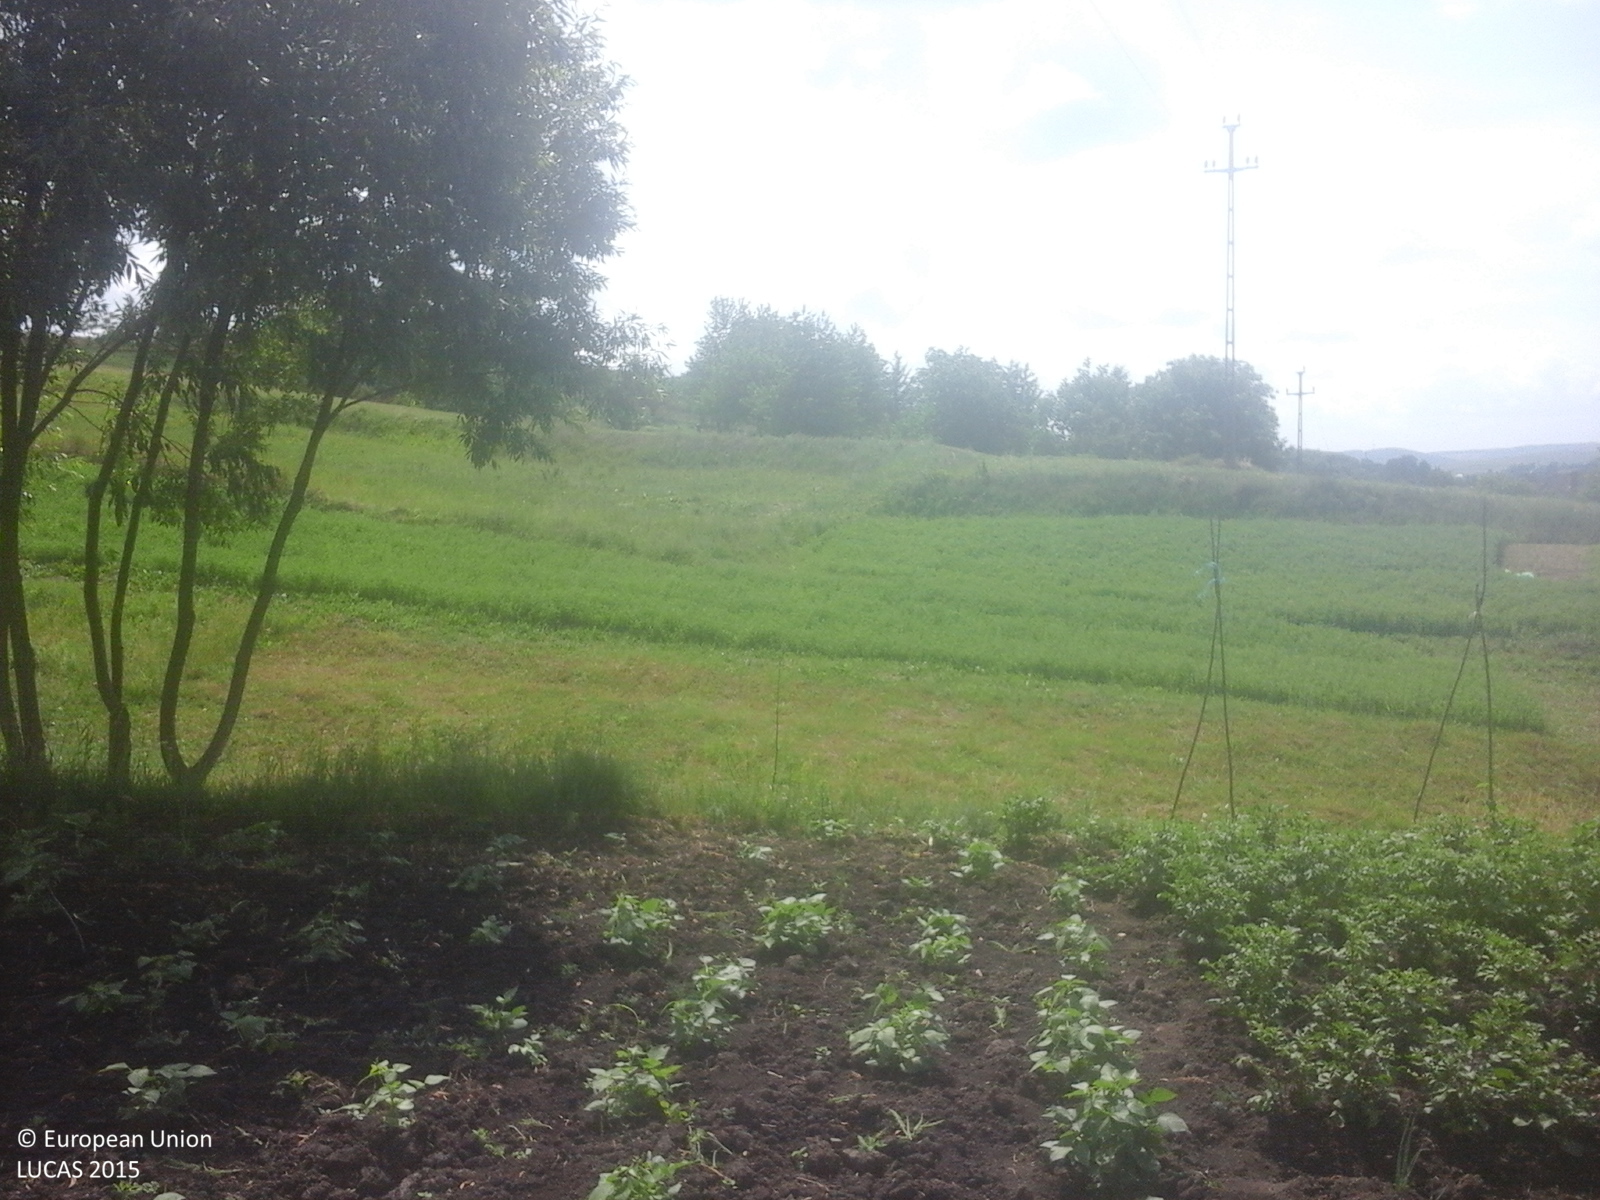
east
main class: Cropland
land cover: Dry pulses
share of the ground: < 10 %
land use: Kitchen garden
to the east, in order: Dry pulses; Single bushes/trees; Grassland without tree/shrub cover; Electric lines; Lucerne; Grassland without tree/shrub cover; Broadleaved woodland; Other leguminous and mixtures for fodder; Grassland with sparse tree/shrub cover
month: June
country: RO
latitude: 47.0448
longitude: 26.3637
